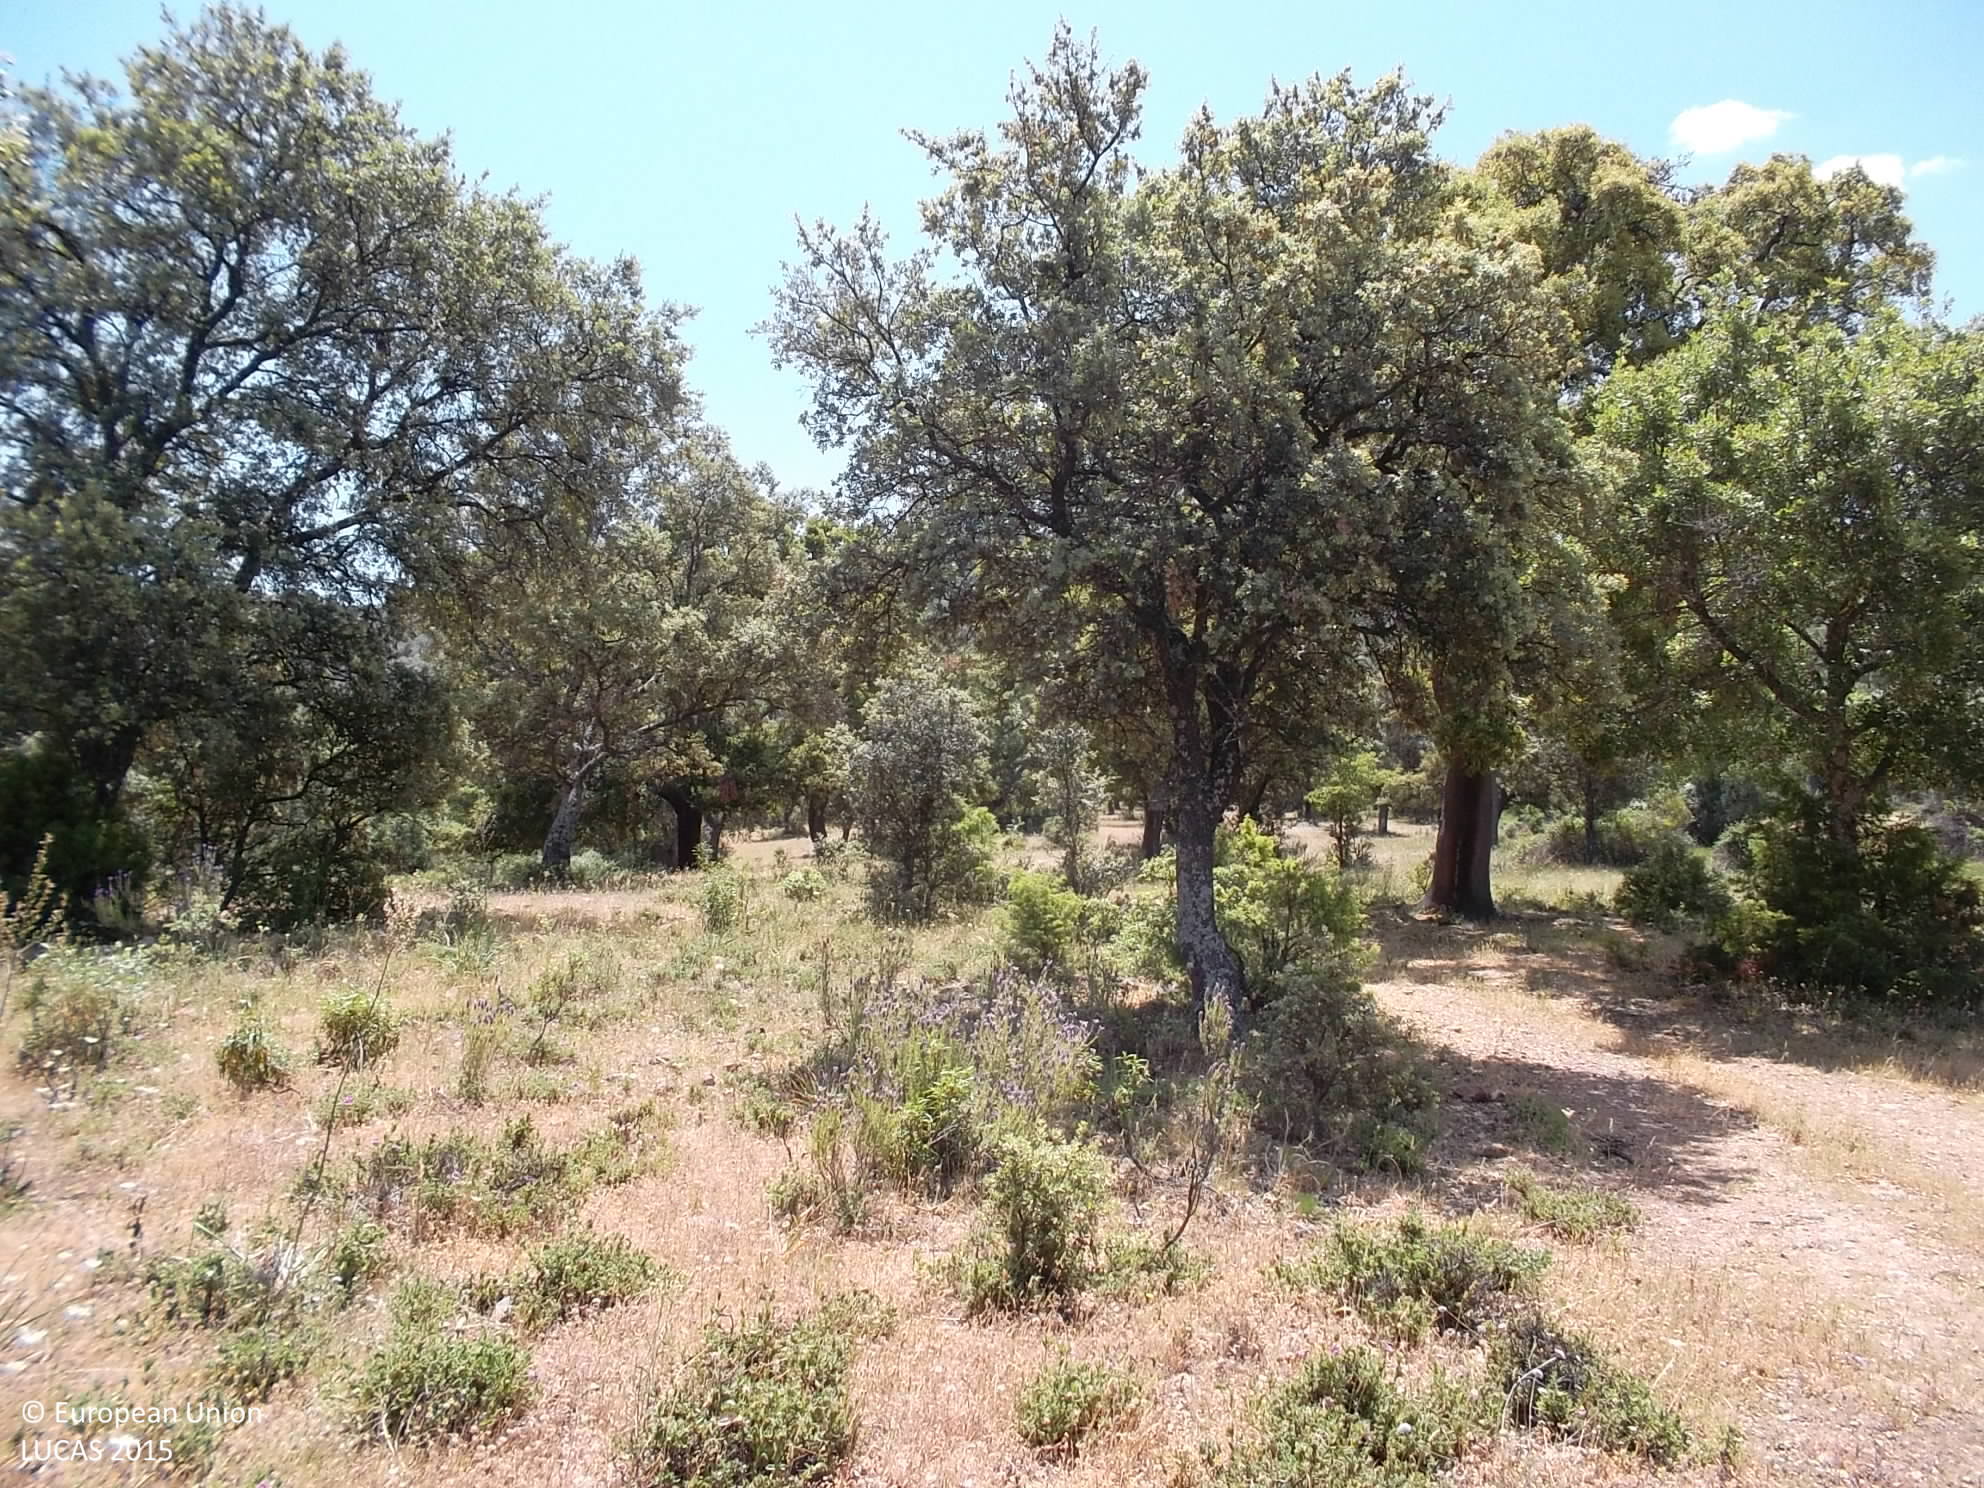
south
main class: Woodland
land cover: Broadleaved woodland
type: broadleaved evergreen forest
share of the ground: 25 - 50 %
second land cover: Spontaneously vegetated surfaces
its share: > 75 %
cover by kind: herbaceous plants 60 %, broadleaved forest trees 40 %
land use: Forestry
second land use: Agriculture (excluding fallow land and kitchen gardens)
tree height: > 5 m
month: May
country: ES
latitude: 38.5422
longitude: -4.3723
